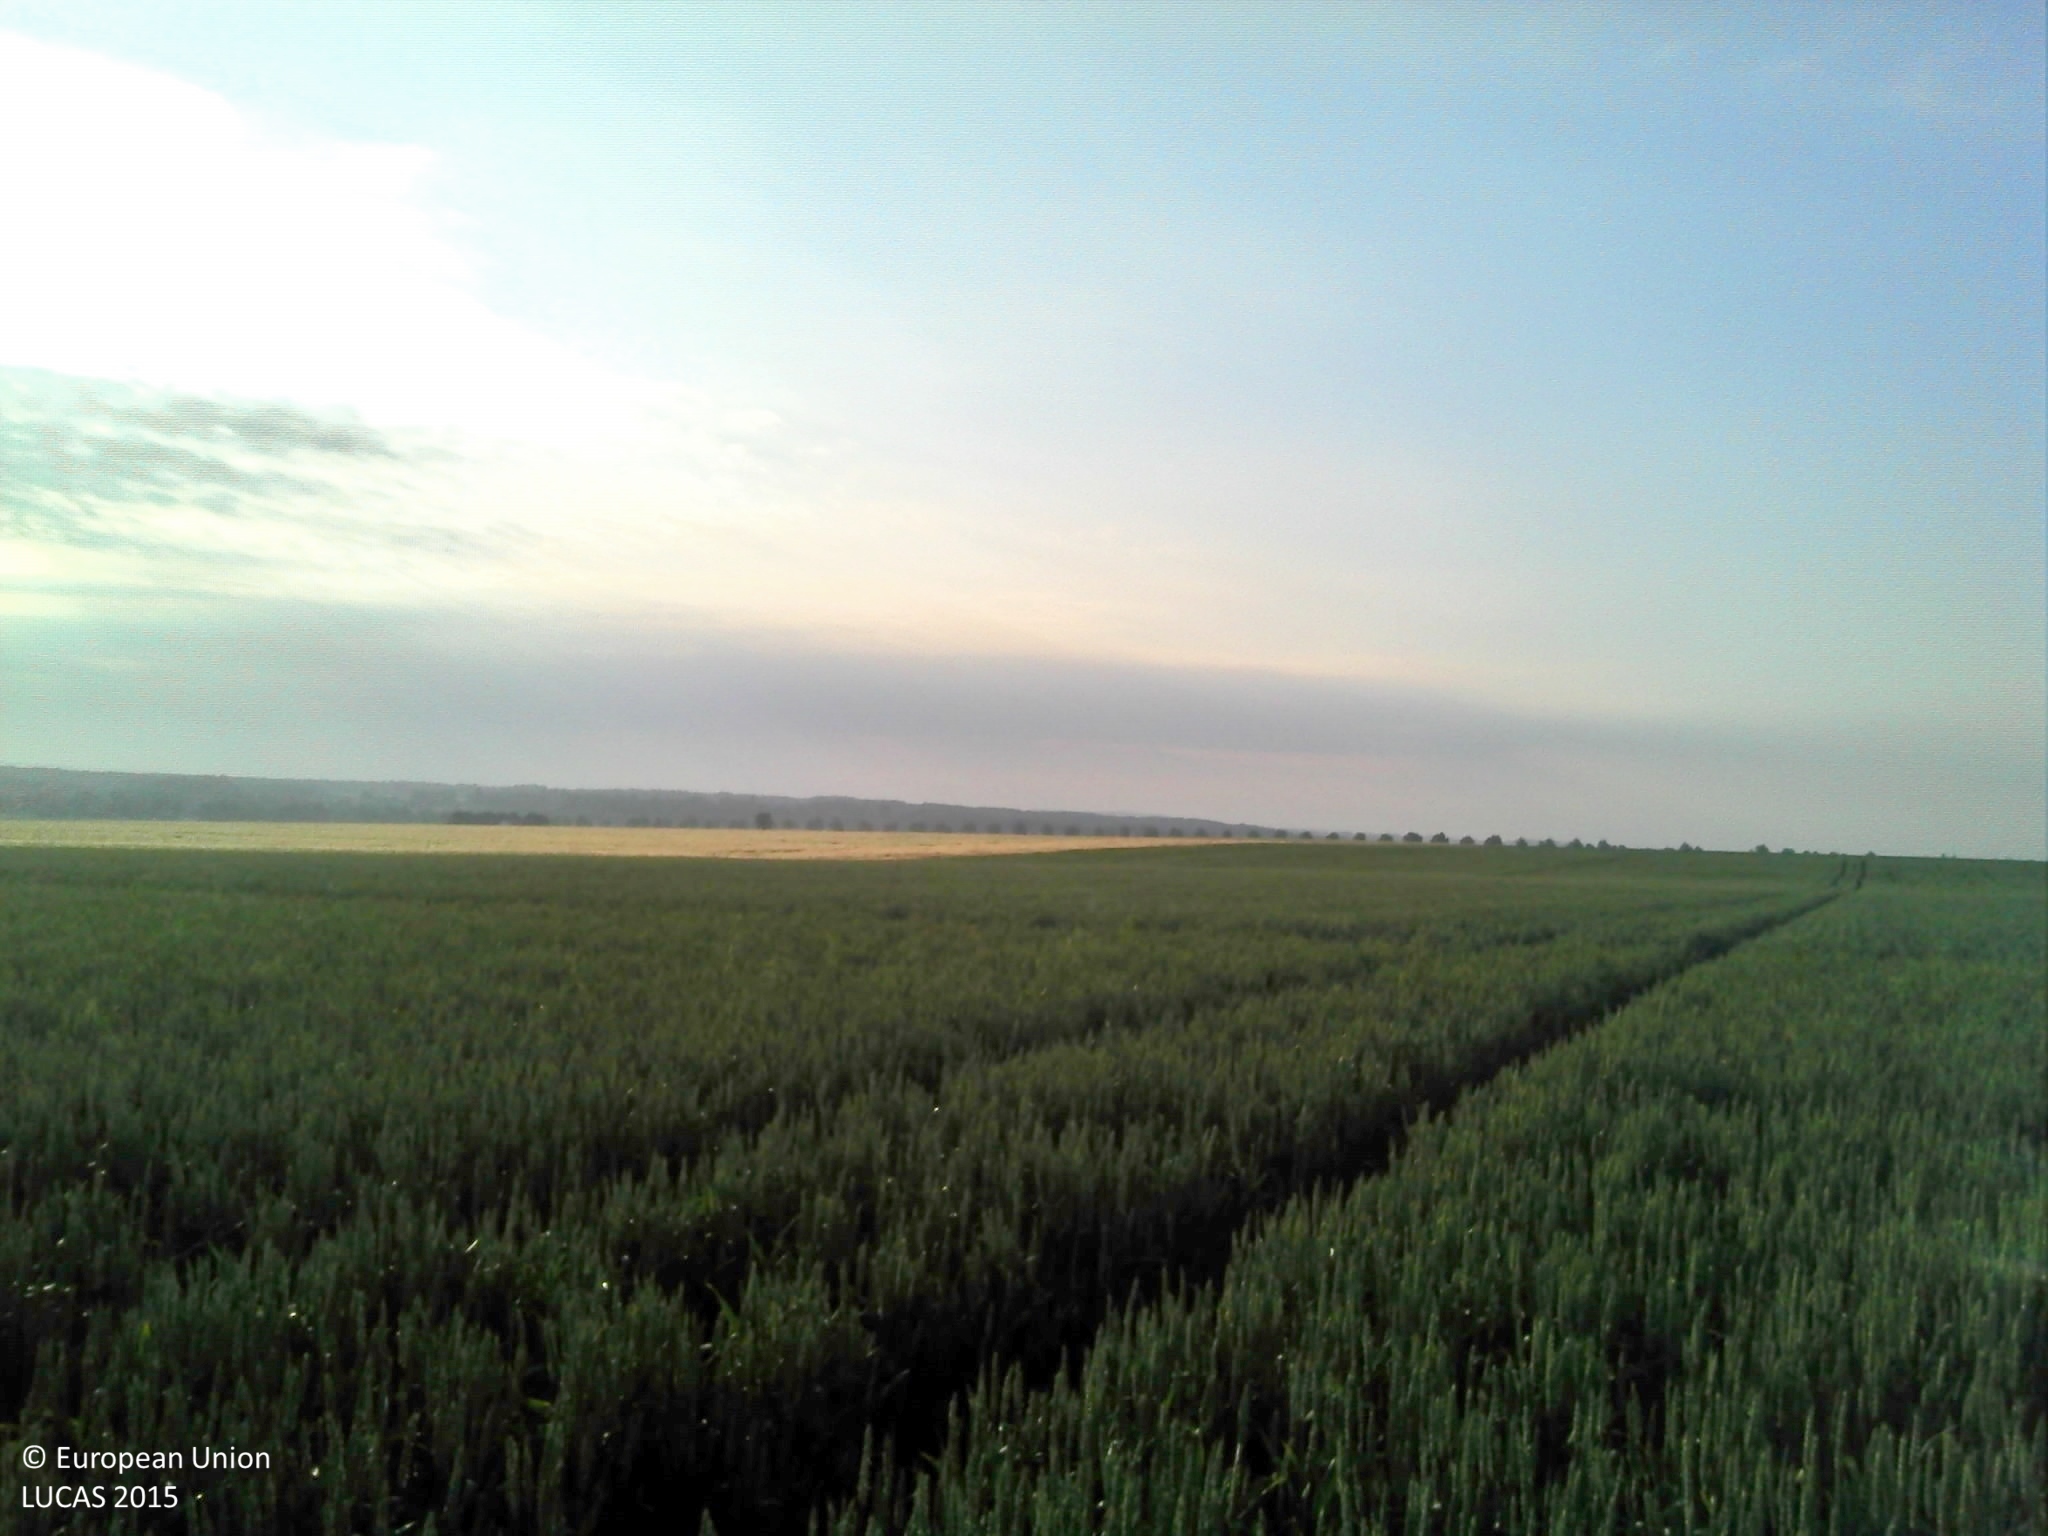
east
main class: Cropland
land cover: Common wheat
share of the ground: > 75 %
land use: Agriculture (excluding fallow land and kitchen gardens)
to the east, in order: Common wheat; Ditches and canals; Triticale
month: June
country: FR
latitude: 49.4208
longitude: 2.6134
